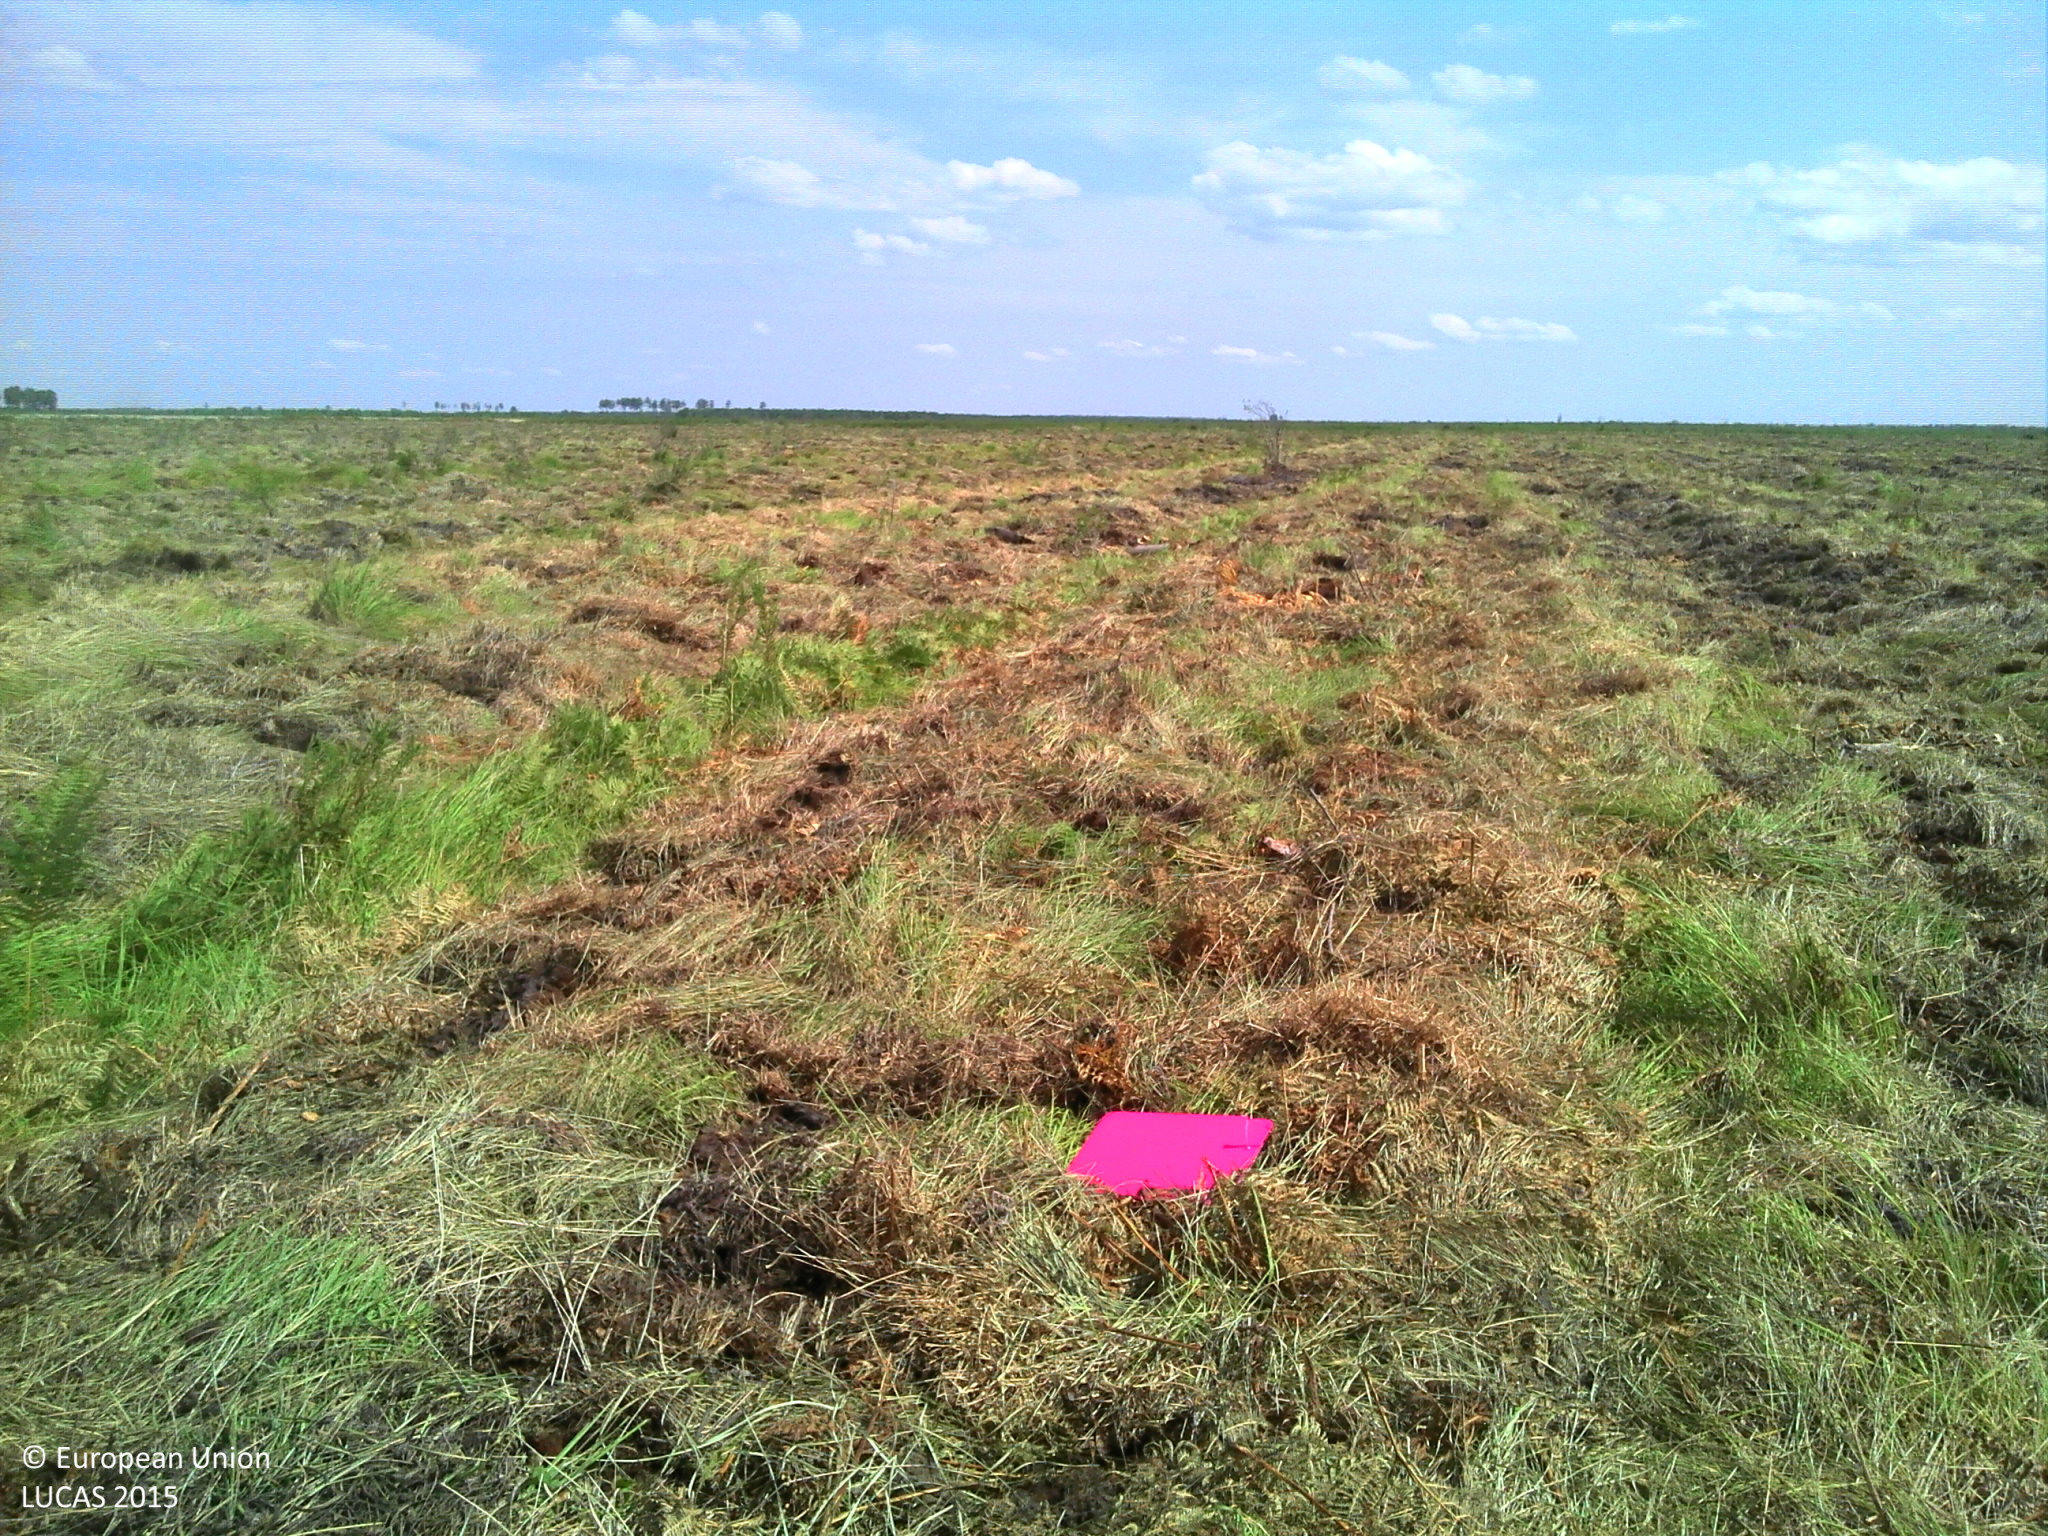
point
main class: Grassland
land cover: Spontaneously vegetated surfaces
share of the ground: > 75 %
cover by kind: herbaceous plants 100 %
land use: Forestry
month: July
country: FR
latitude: 44.2198
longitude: -0.6424
